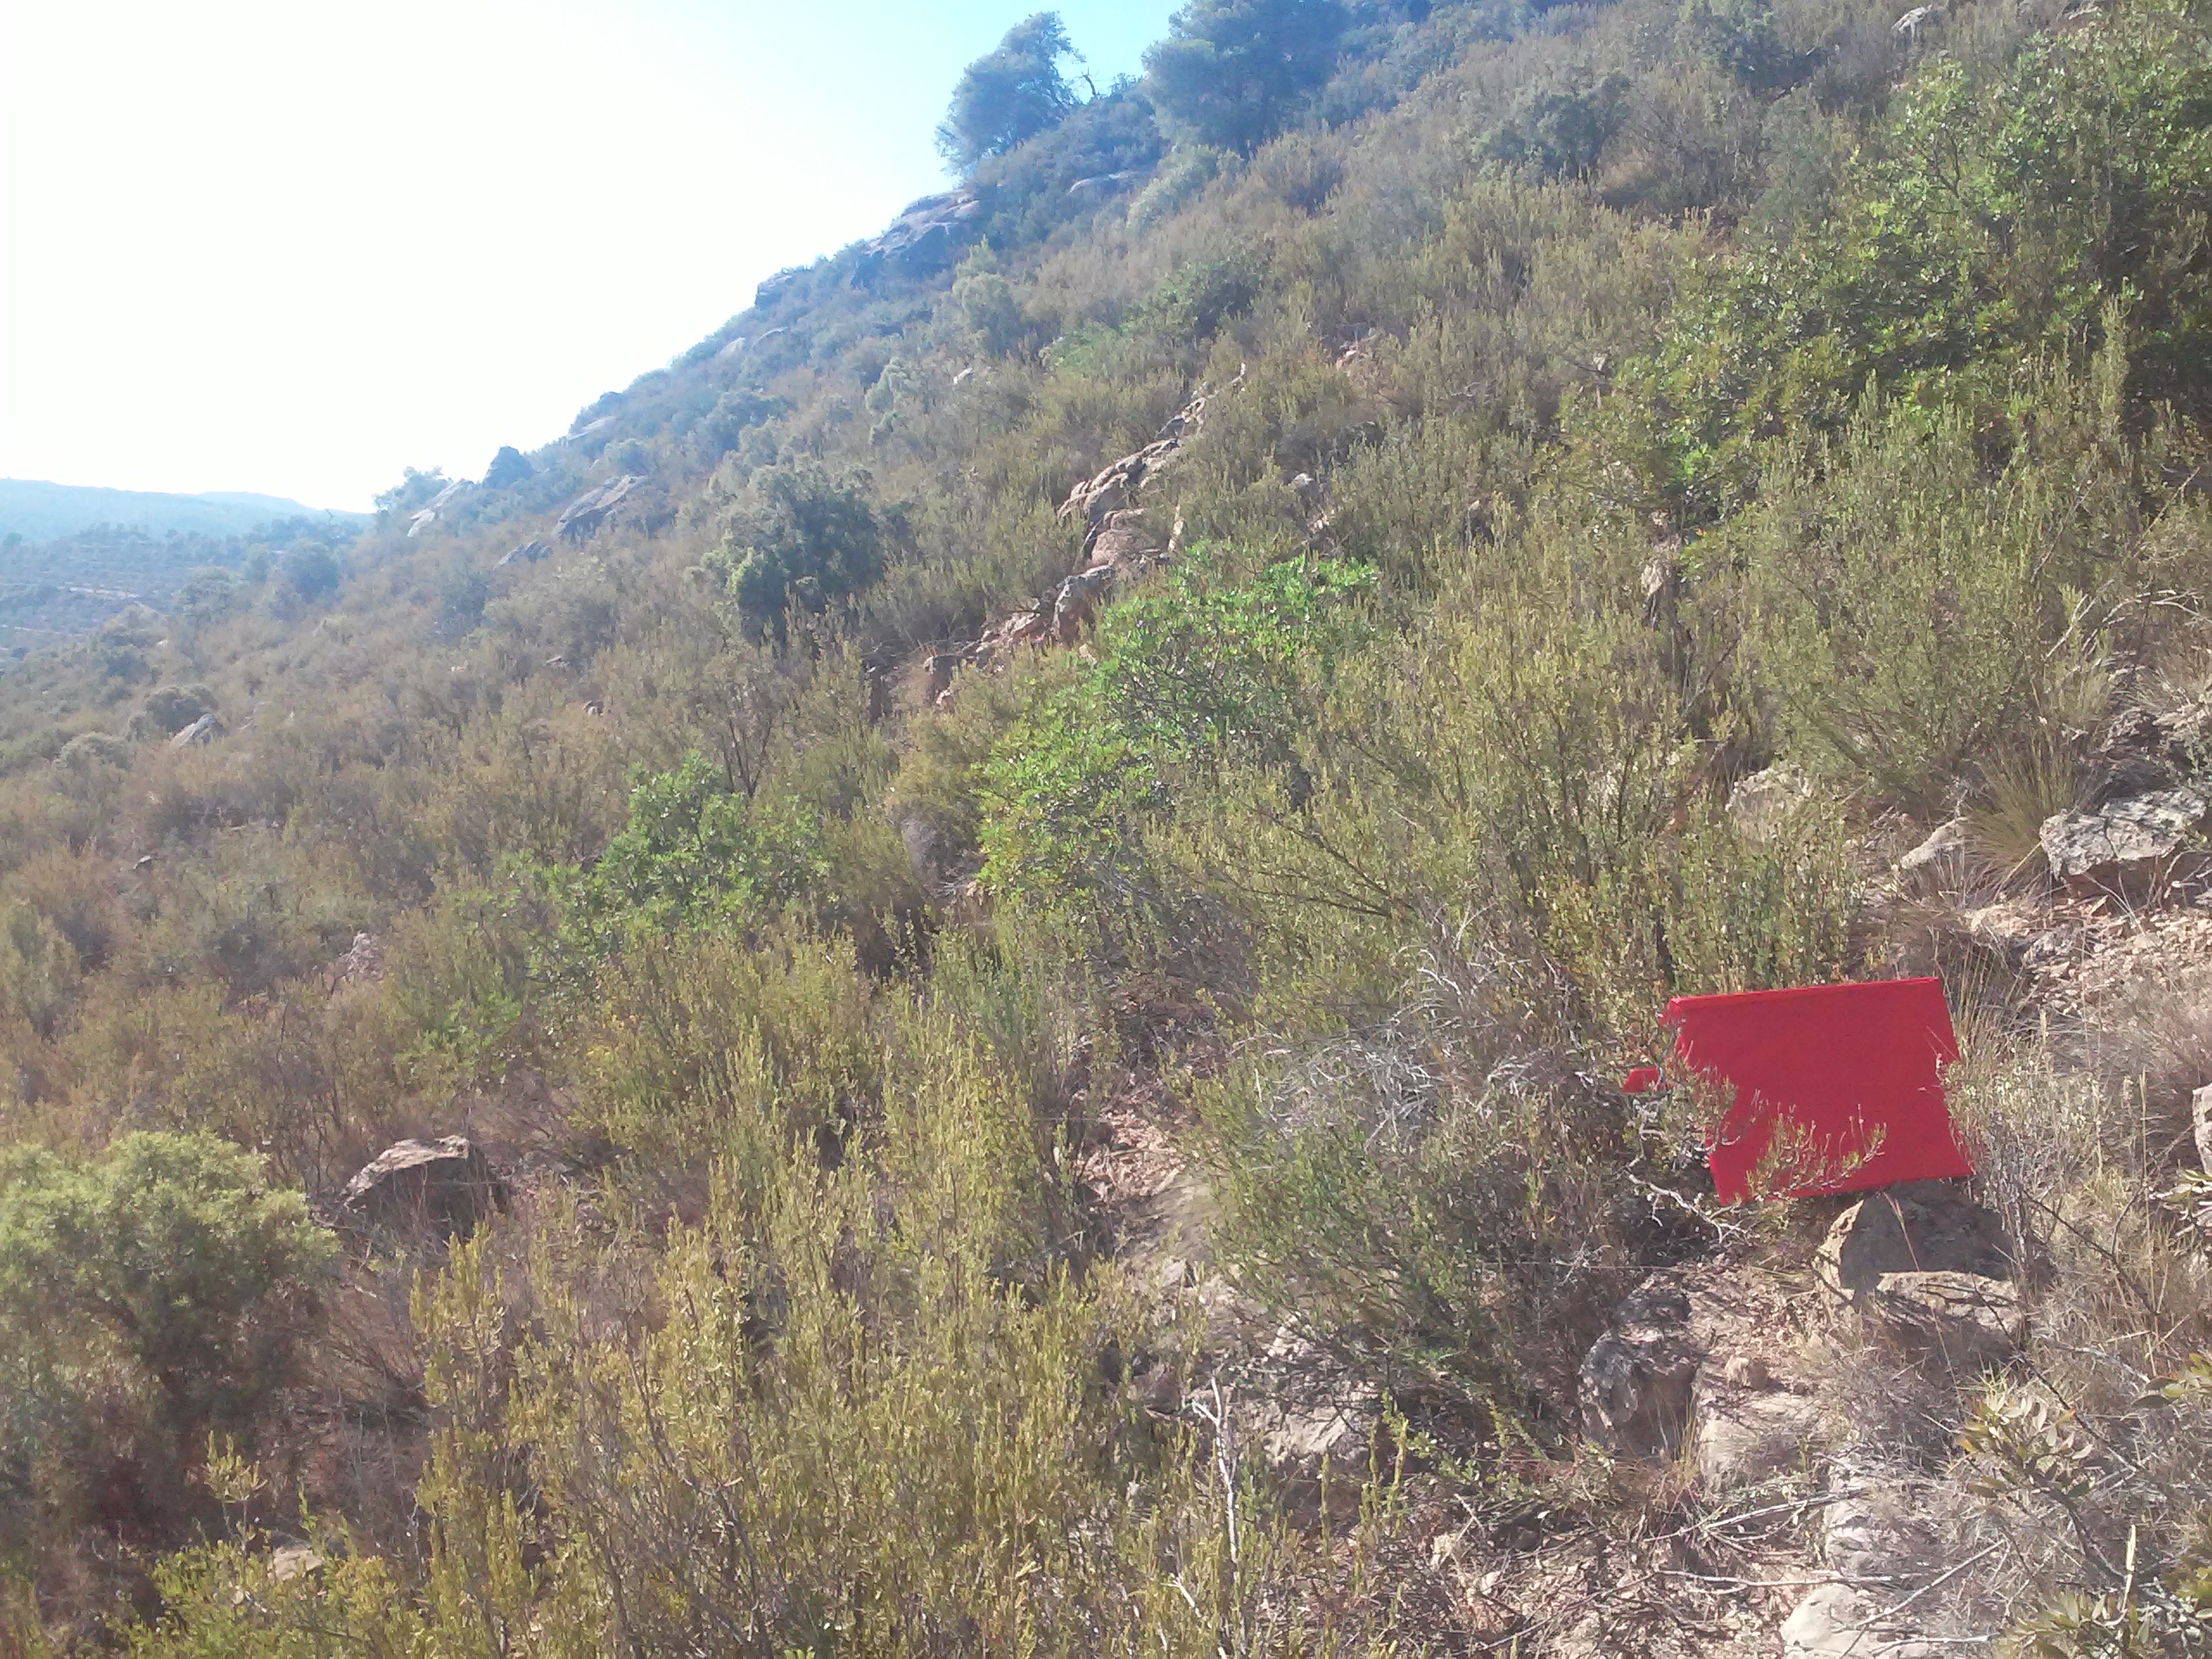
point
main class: Shrubland
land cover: Shrubland with sparse tree cover
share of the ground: 50 - 75 %
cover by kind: shrubs 60 %, herbaceous plants 30 %, coniferous forest trees 5 %, consolidated bare surface 5 %
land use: Semi-natural and natural areas not in use
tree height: < 5 m
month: August
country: ES
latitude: 41.3196
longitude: 0.5401
